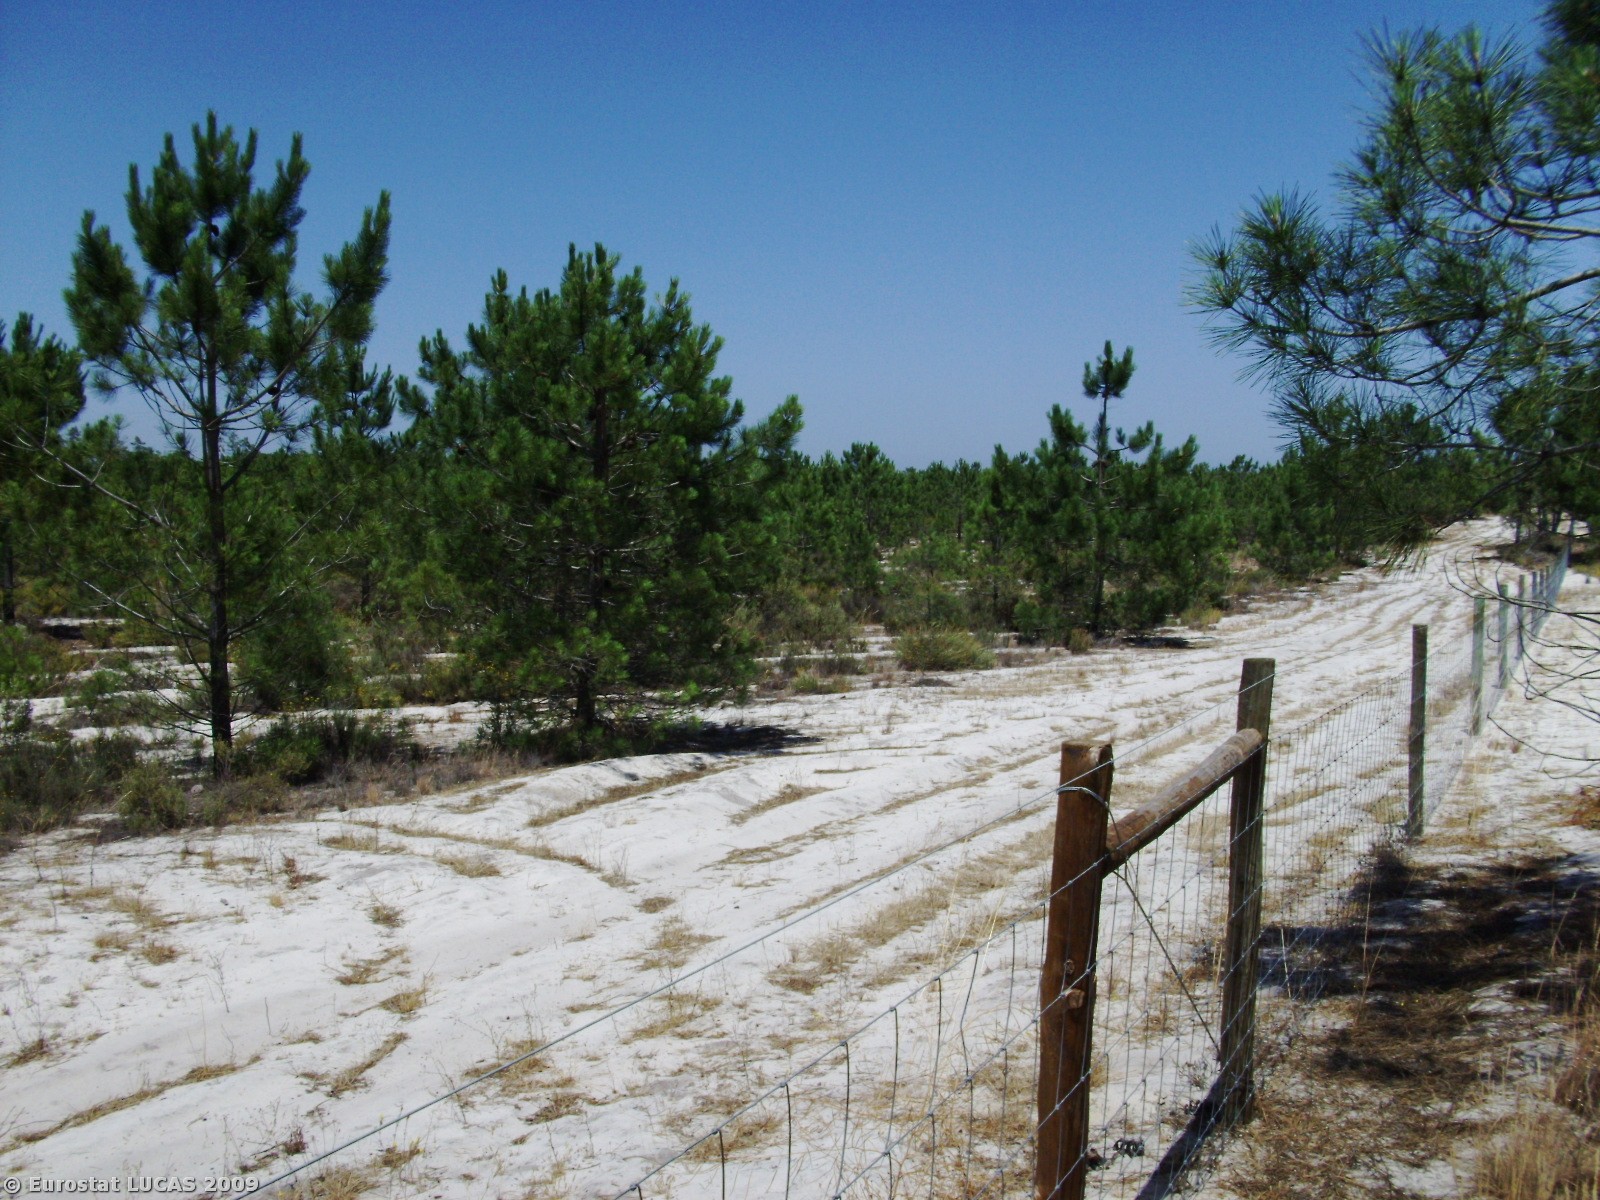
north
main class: Woodland
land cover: Coniferous woodland
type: coniferous forest of the mediterranean region
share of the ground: 25 - 50 %
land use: Forestry
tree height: > 5 m
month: June
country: PT
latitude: 38.3807
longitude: -8.7747
